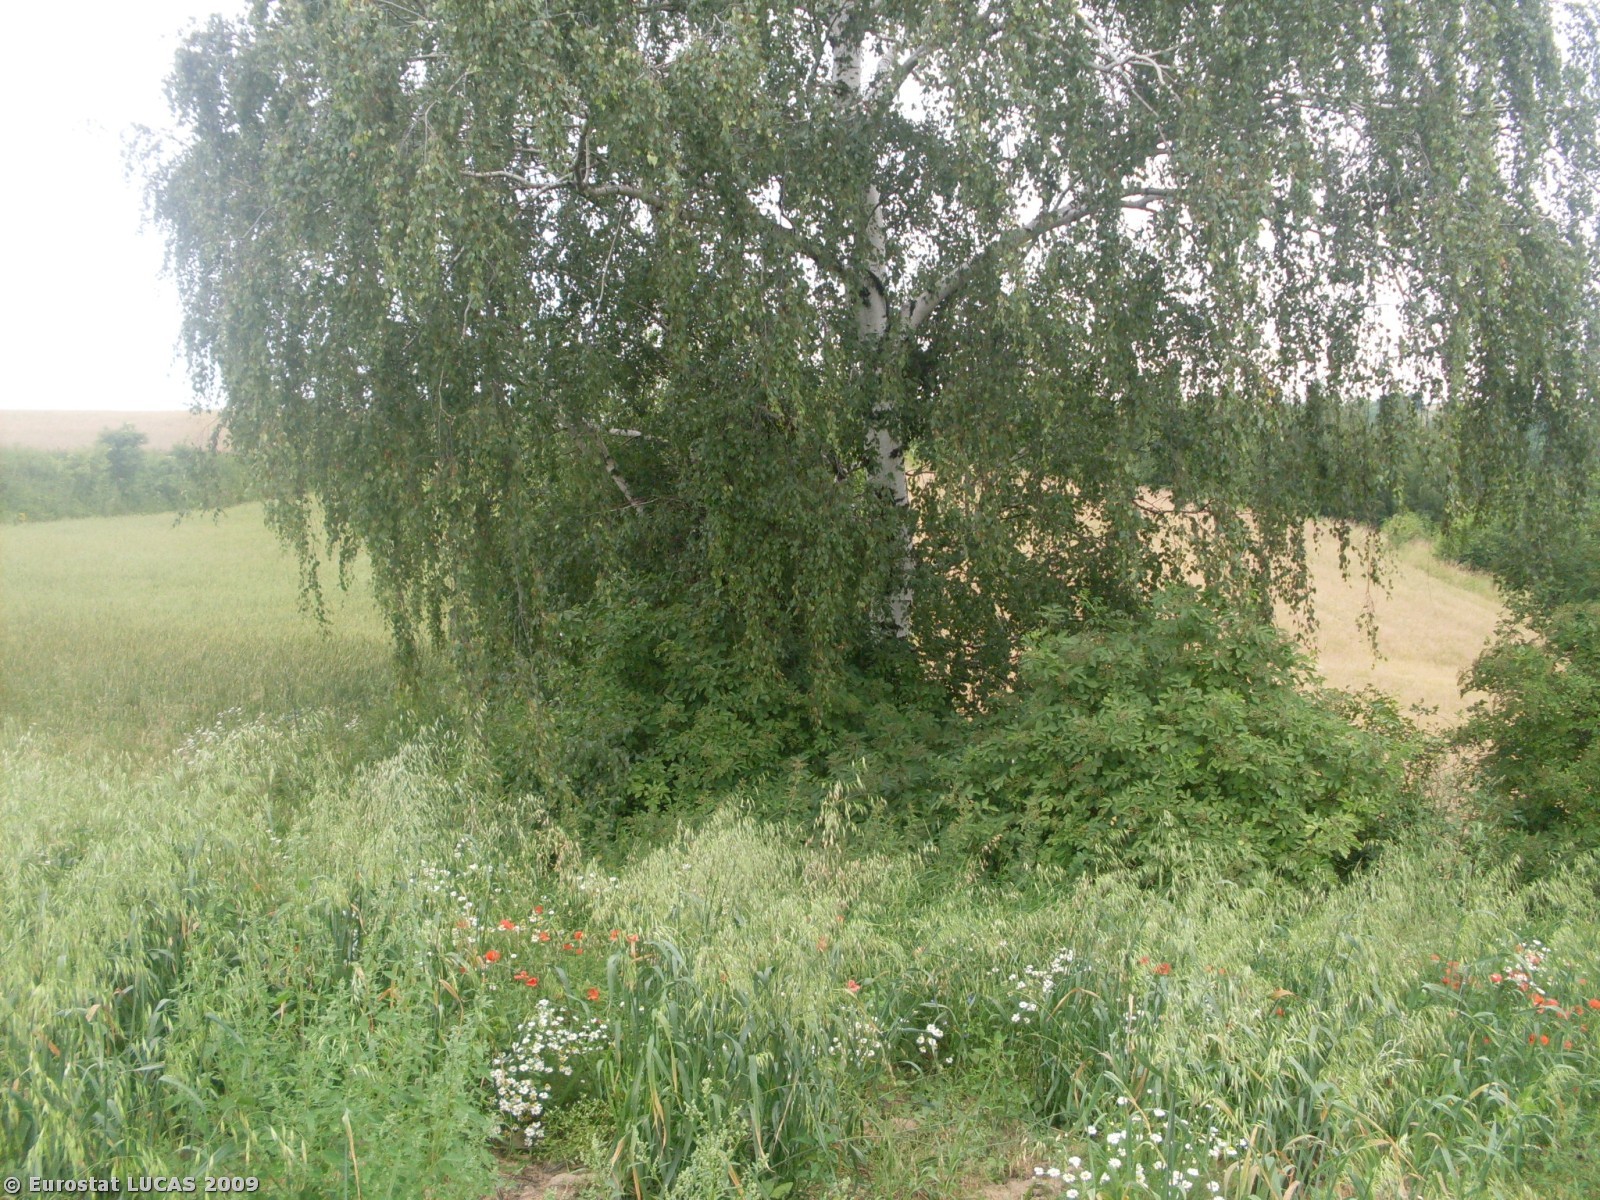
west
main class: Grassland
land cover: Spontaneously vegetated surfaces
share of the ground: > 75 %
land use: Unused
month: July
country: PL
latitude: 50.1825
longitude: 20.5557
